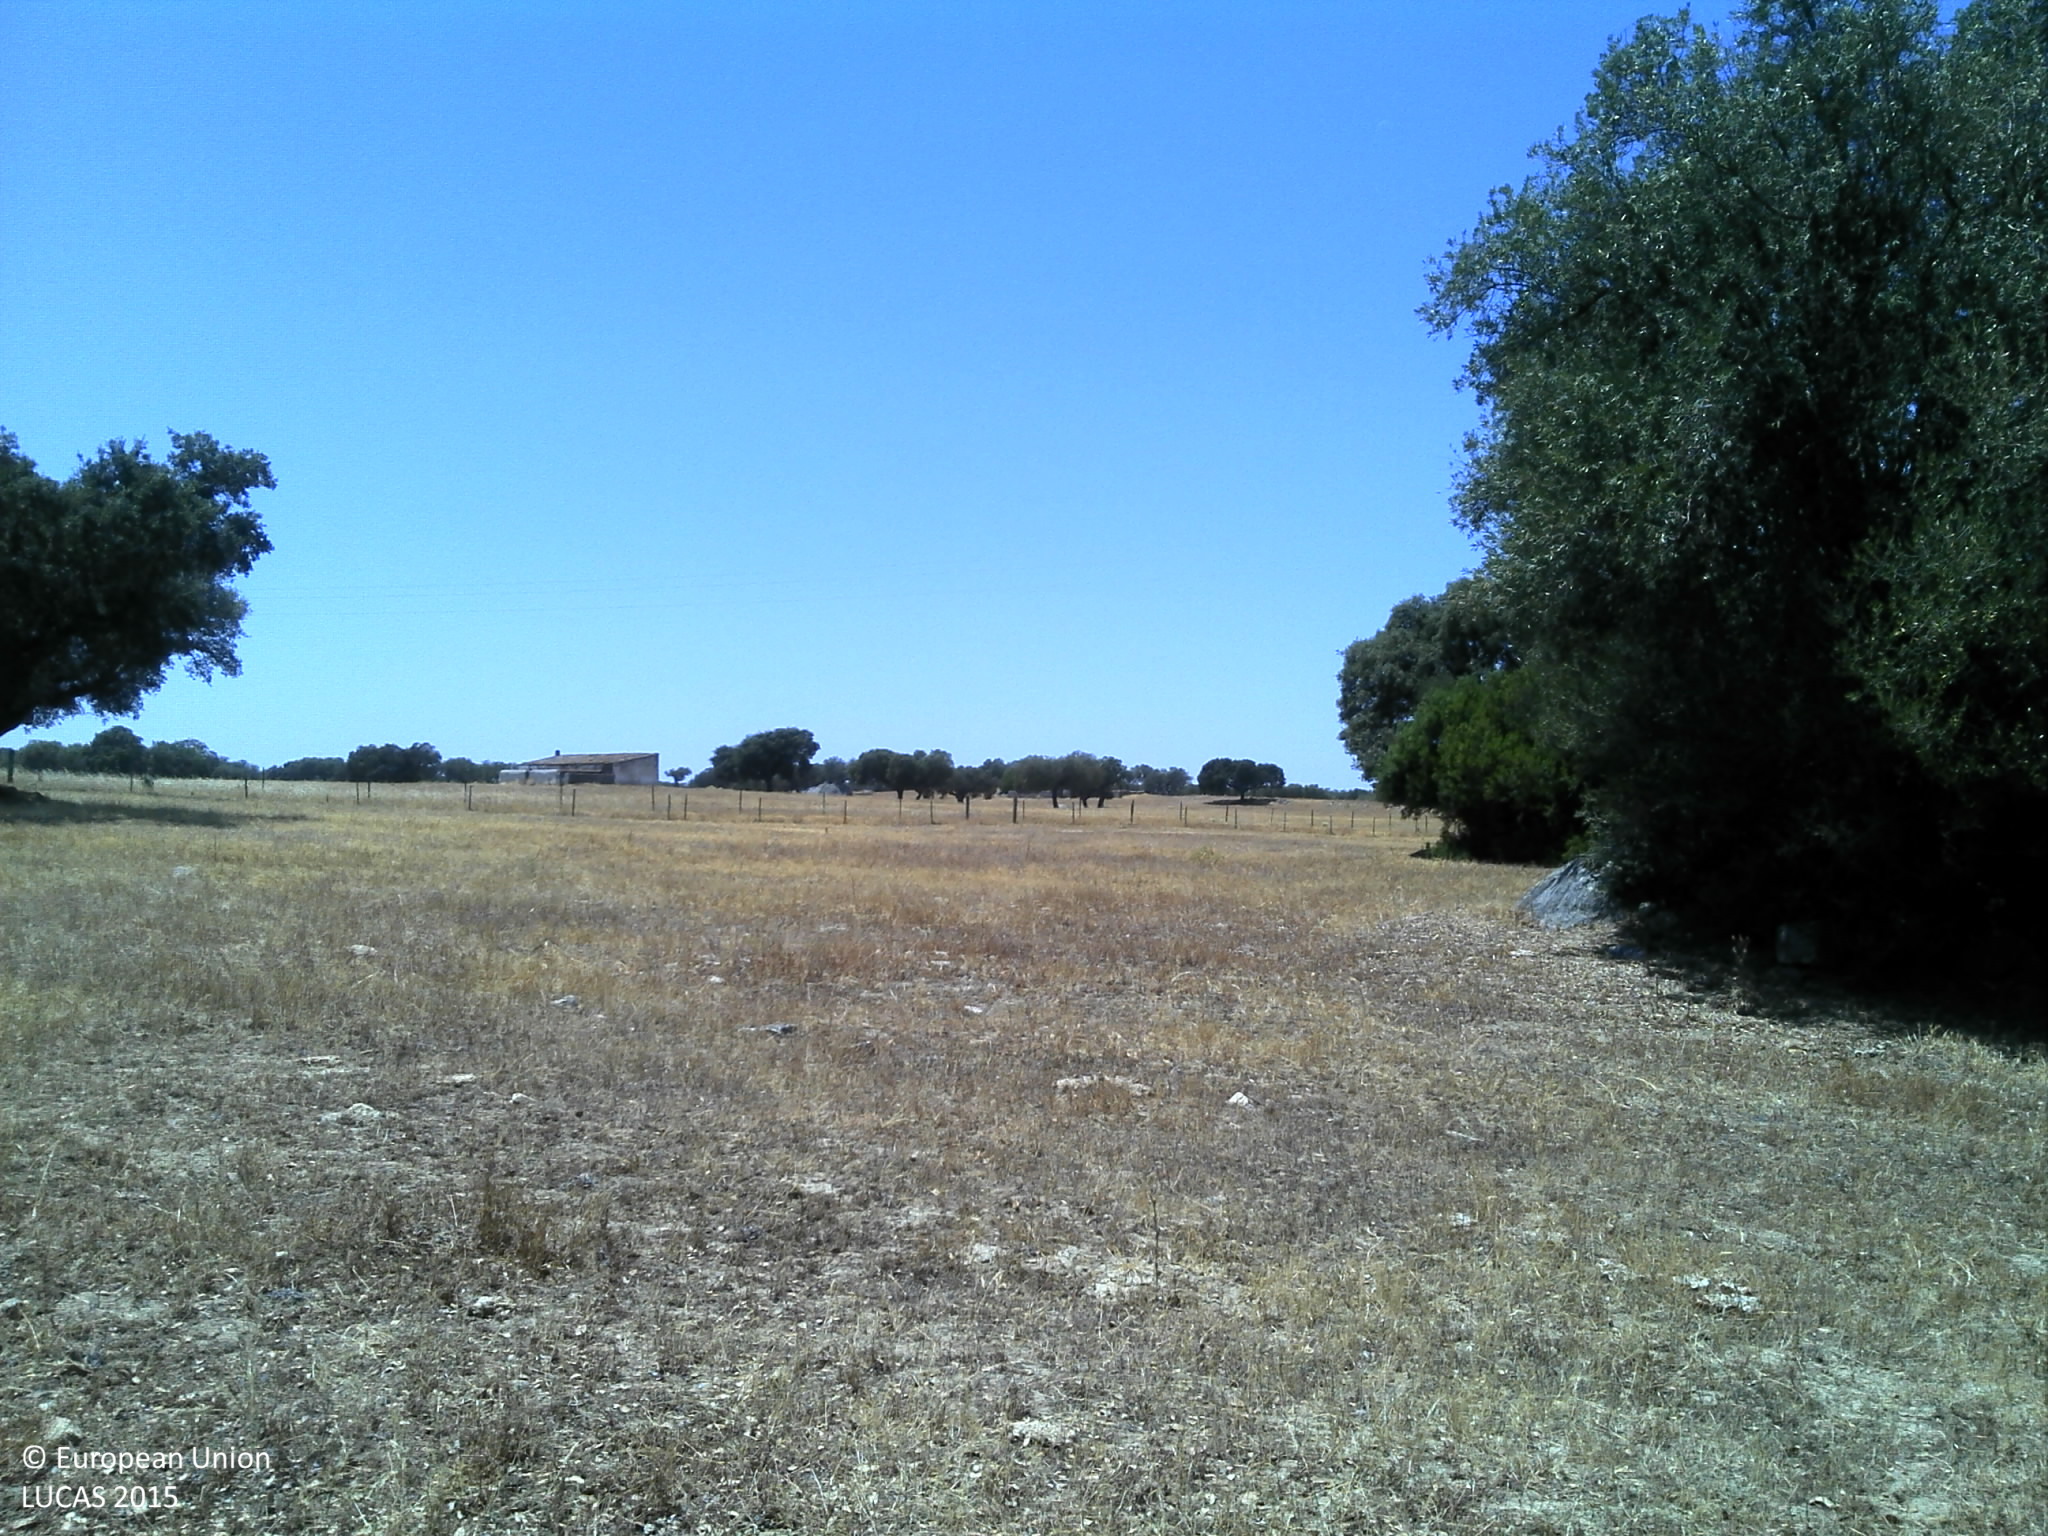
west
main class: Woodland
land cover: Broadleaved woodland
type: broadleaved evergreen forest
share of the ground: 25 - 50 %
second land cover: Grassland without tree/shrub cover
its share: 25 - 50 %
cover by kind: unconsolidated bare surface 45 %, herbaceous plants 30 %, broadleaved forest trees 25 %
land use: Forestry
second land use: Agriculture (excluding fallow land and kitchen gardens)
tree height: > 5 m
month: July
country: PT
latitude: 38.4095
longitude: -7.4676
